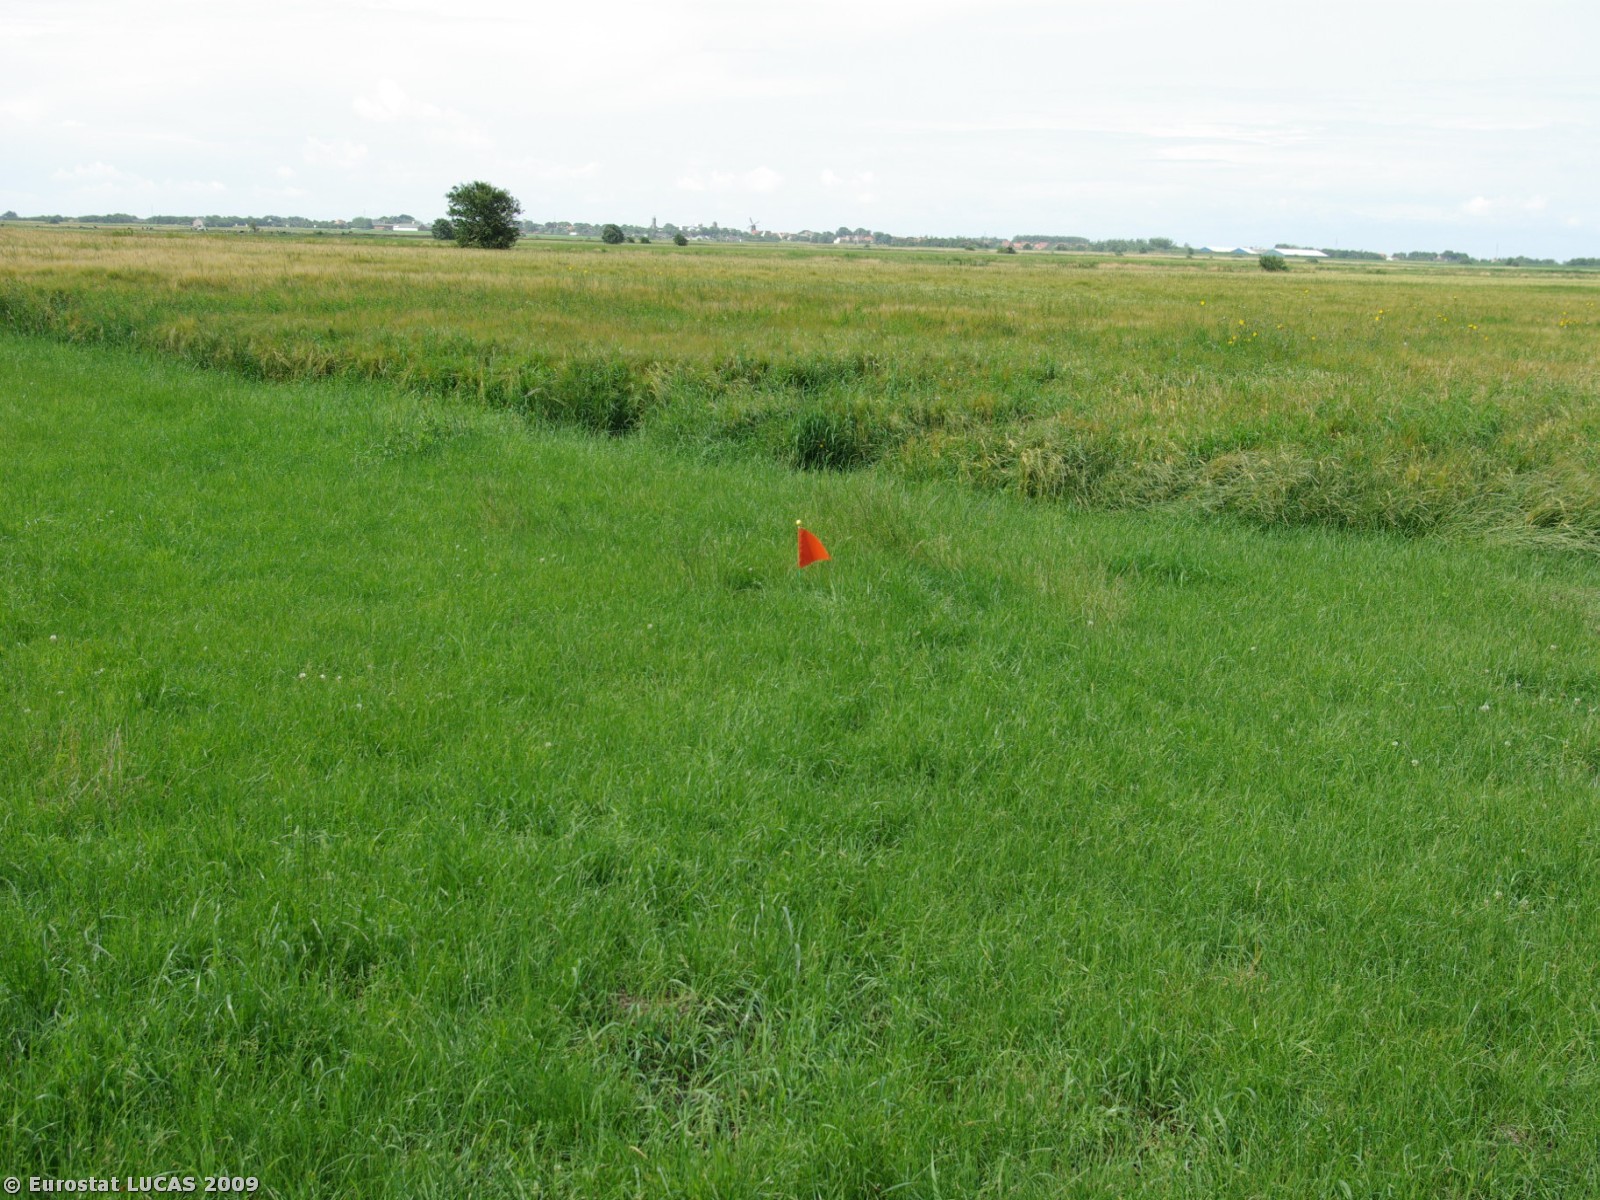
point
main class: Grassland
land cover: Grassland without tree/shrub cover
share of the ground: > 75 %
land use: Agriculture (excluding fallow land and kitchen gardens)
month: July
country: DK
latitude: 54.9771
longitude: 8.7354
